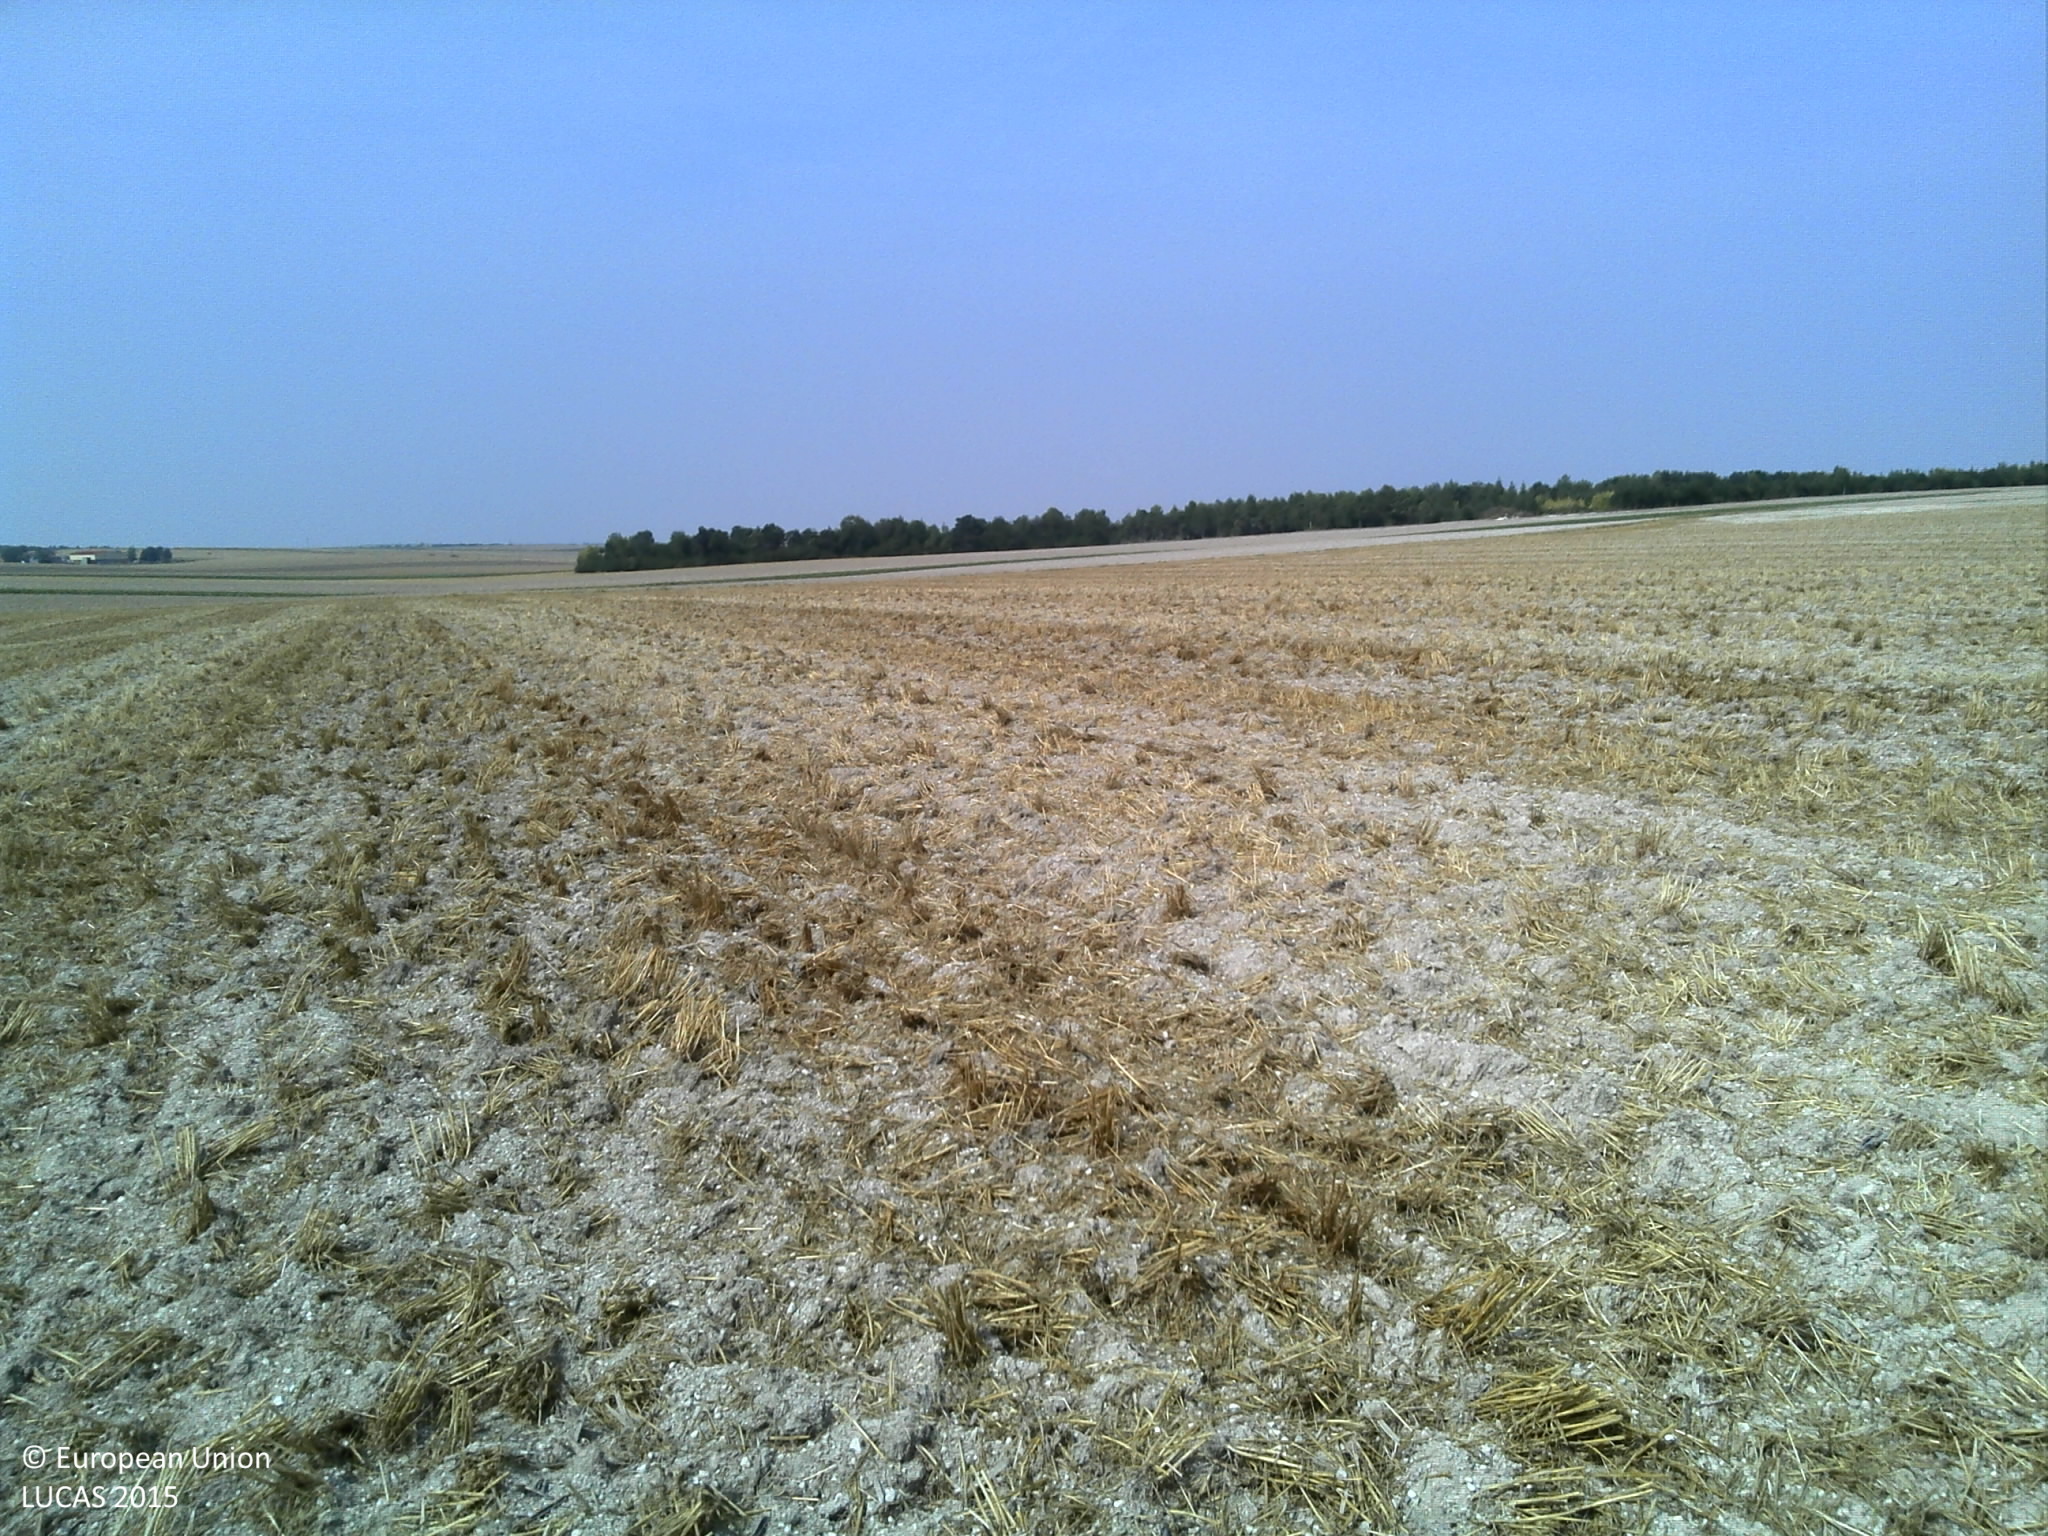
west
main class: Cropland
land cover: Common wheat
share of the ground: > 75 %
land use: Agriculture (excluding fallow land and kitchen gardens)
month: August
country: FR
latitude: 49.0492
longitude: 4.6472
